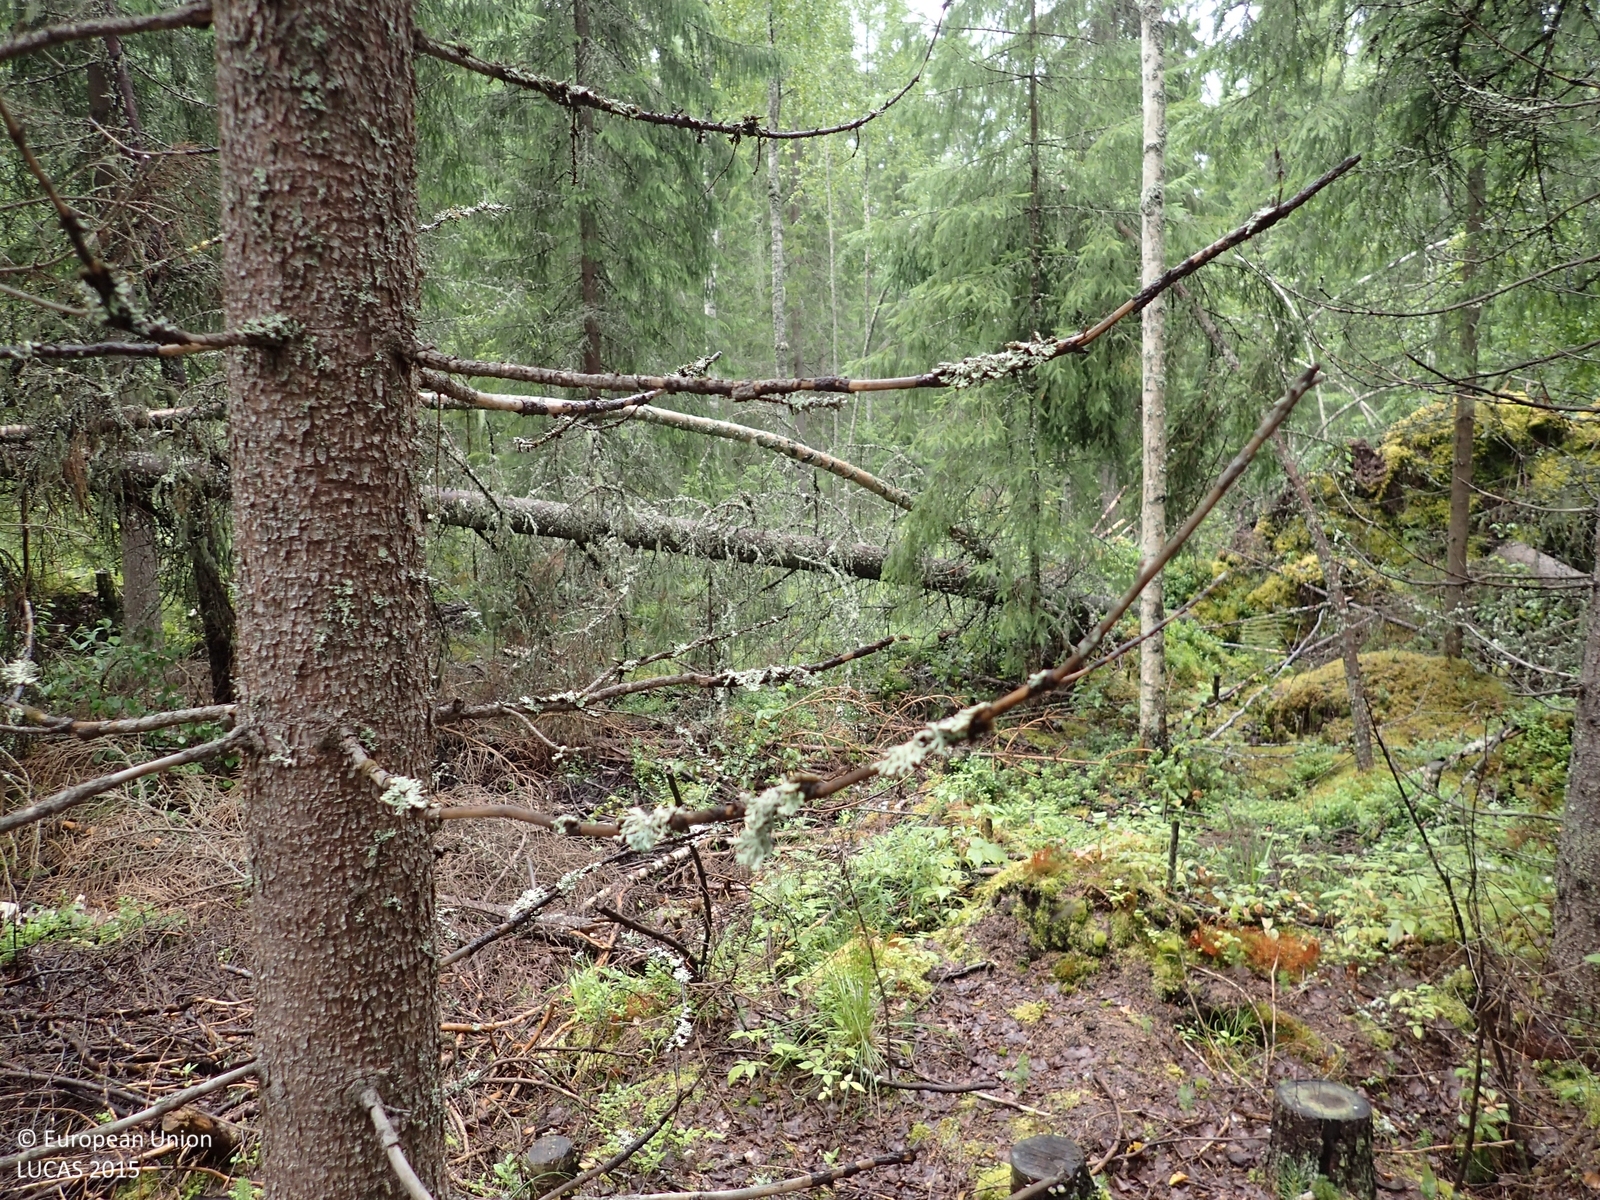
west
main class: Woodland
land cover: Spruce dominated mixed woodland
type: boreal forest
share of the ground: > 75 %
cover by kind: coniferous forest trees 55 %, broadleaved forest trees 20 %, shrubs 15 %, herbaceous plants 5 %, lichens and mosses 5 %
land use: Forestry
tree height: > 5 m
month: July
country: FI
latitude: 62.9774
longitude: 22.8205
